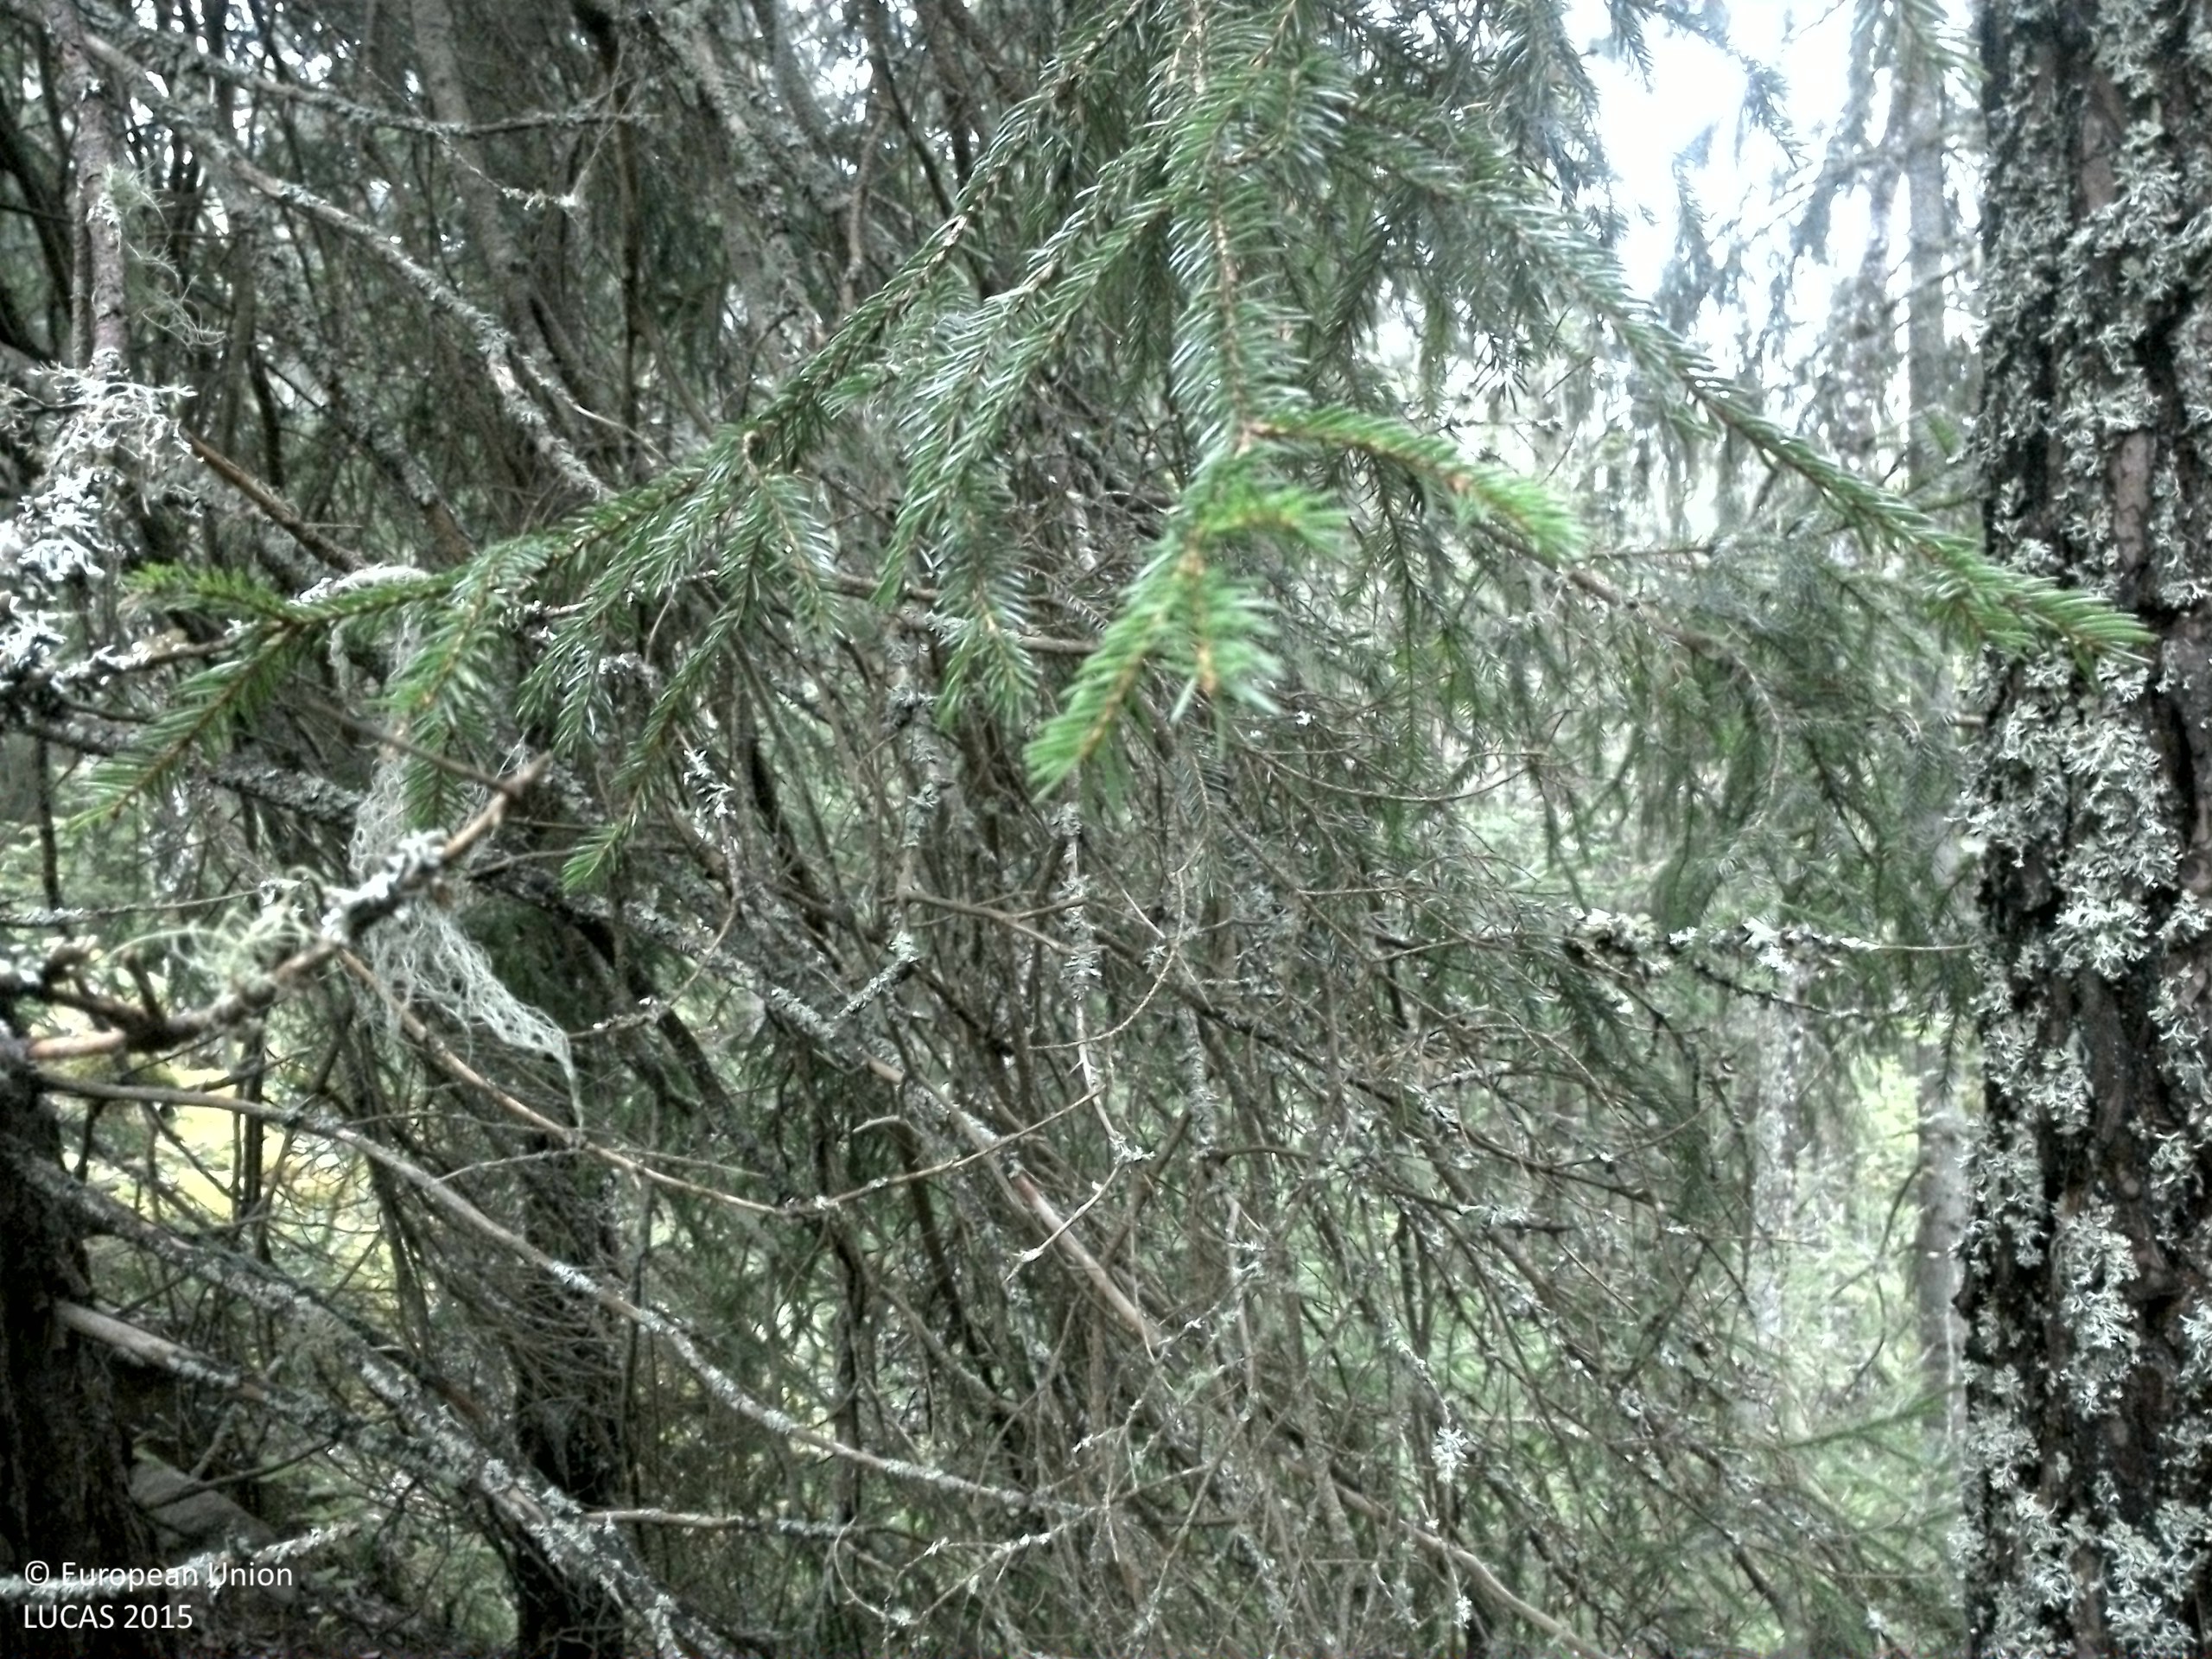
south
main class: Woodland
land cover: Spruce dominated coniferous woodland
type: boreal forest
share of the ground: 25 - 50 %
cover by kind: coniferous forest trees 45 %, lichens and mosses 30 %, shrubs 10 %, herbaceous plants 10 %, broadleaved forest trees 5 %
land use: Amenities, museums, leisure
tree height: > 5 m
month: September
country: SE
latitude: 59.8376
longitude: 13.2212
